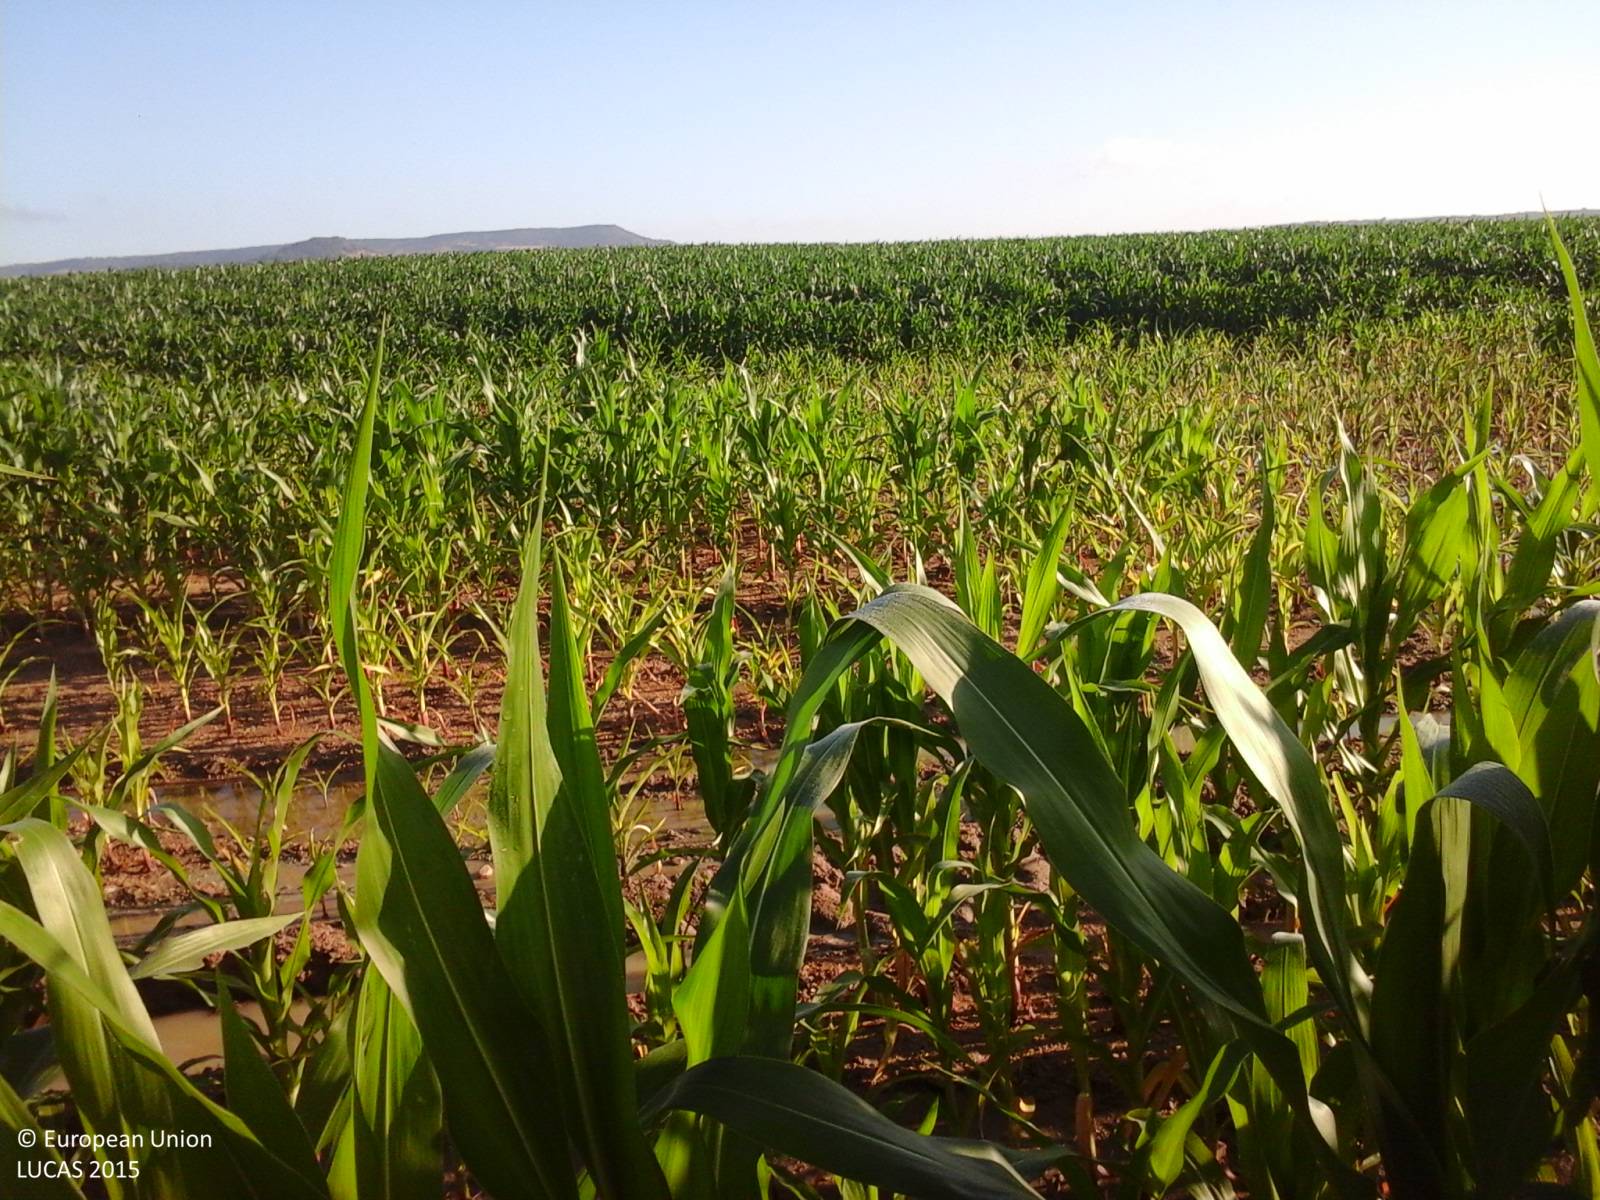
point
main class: Cropland
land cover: Maize
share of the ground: > 75 %
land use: Agriculture (excluding fallow land and kitchen gardens)
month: July
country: IT
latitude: 40.6227
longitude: 8.8590
